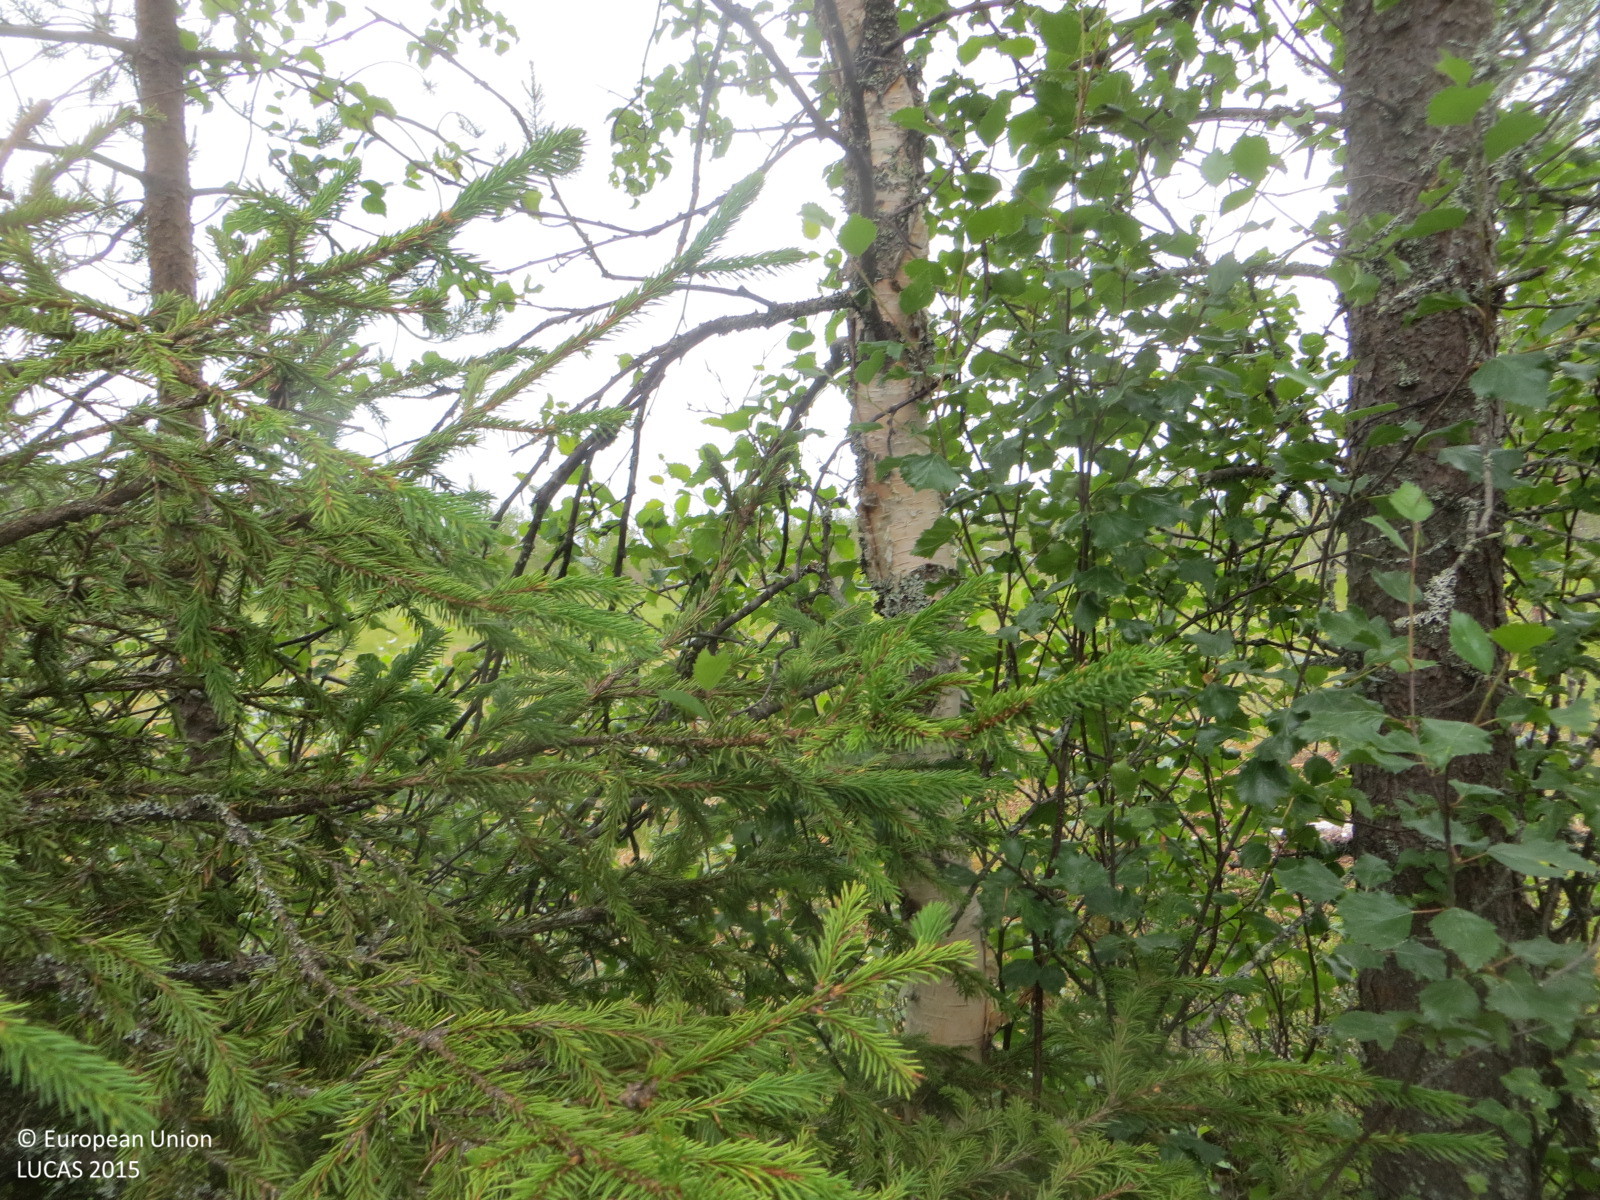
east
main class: Woodland
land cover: Pine dominated coniferous woodland
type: mire and swamp forests
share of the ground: 50 - 75 %
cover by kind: coniferous forest trees 65 %, shrubs 35 %
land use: Forestry
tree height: > 5 m
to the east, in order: Pine dominated coniferous woodland; Ditches and canals; Other coniferous woodland; Pine dominated coniferous woodland; Tracks; Pine dominated coniferous woodland; Tracks; Pine dominated coniferous woodland; Ditches and canals; Pine dominated coniferous woodland; Other coniferous woodland; Peatbogs
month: July
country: FI
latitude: 66.3923
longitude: 25.8491
